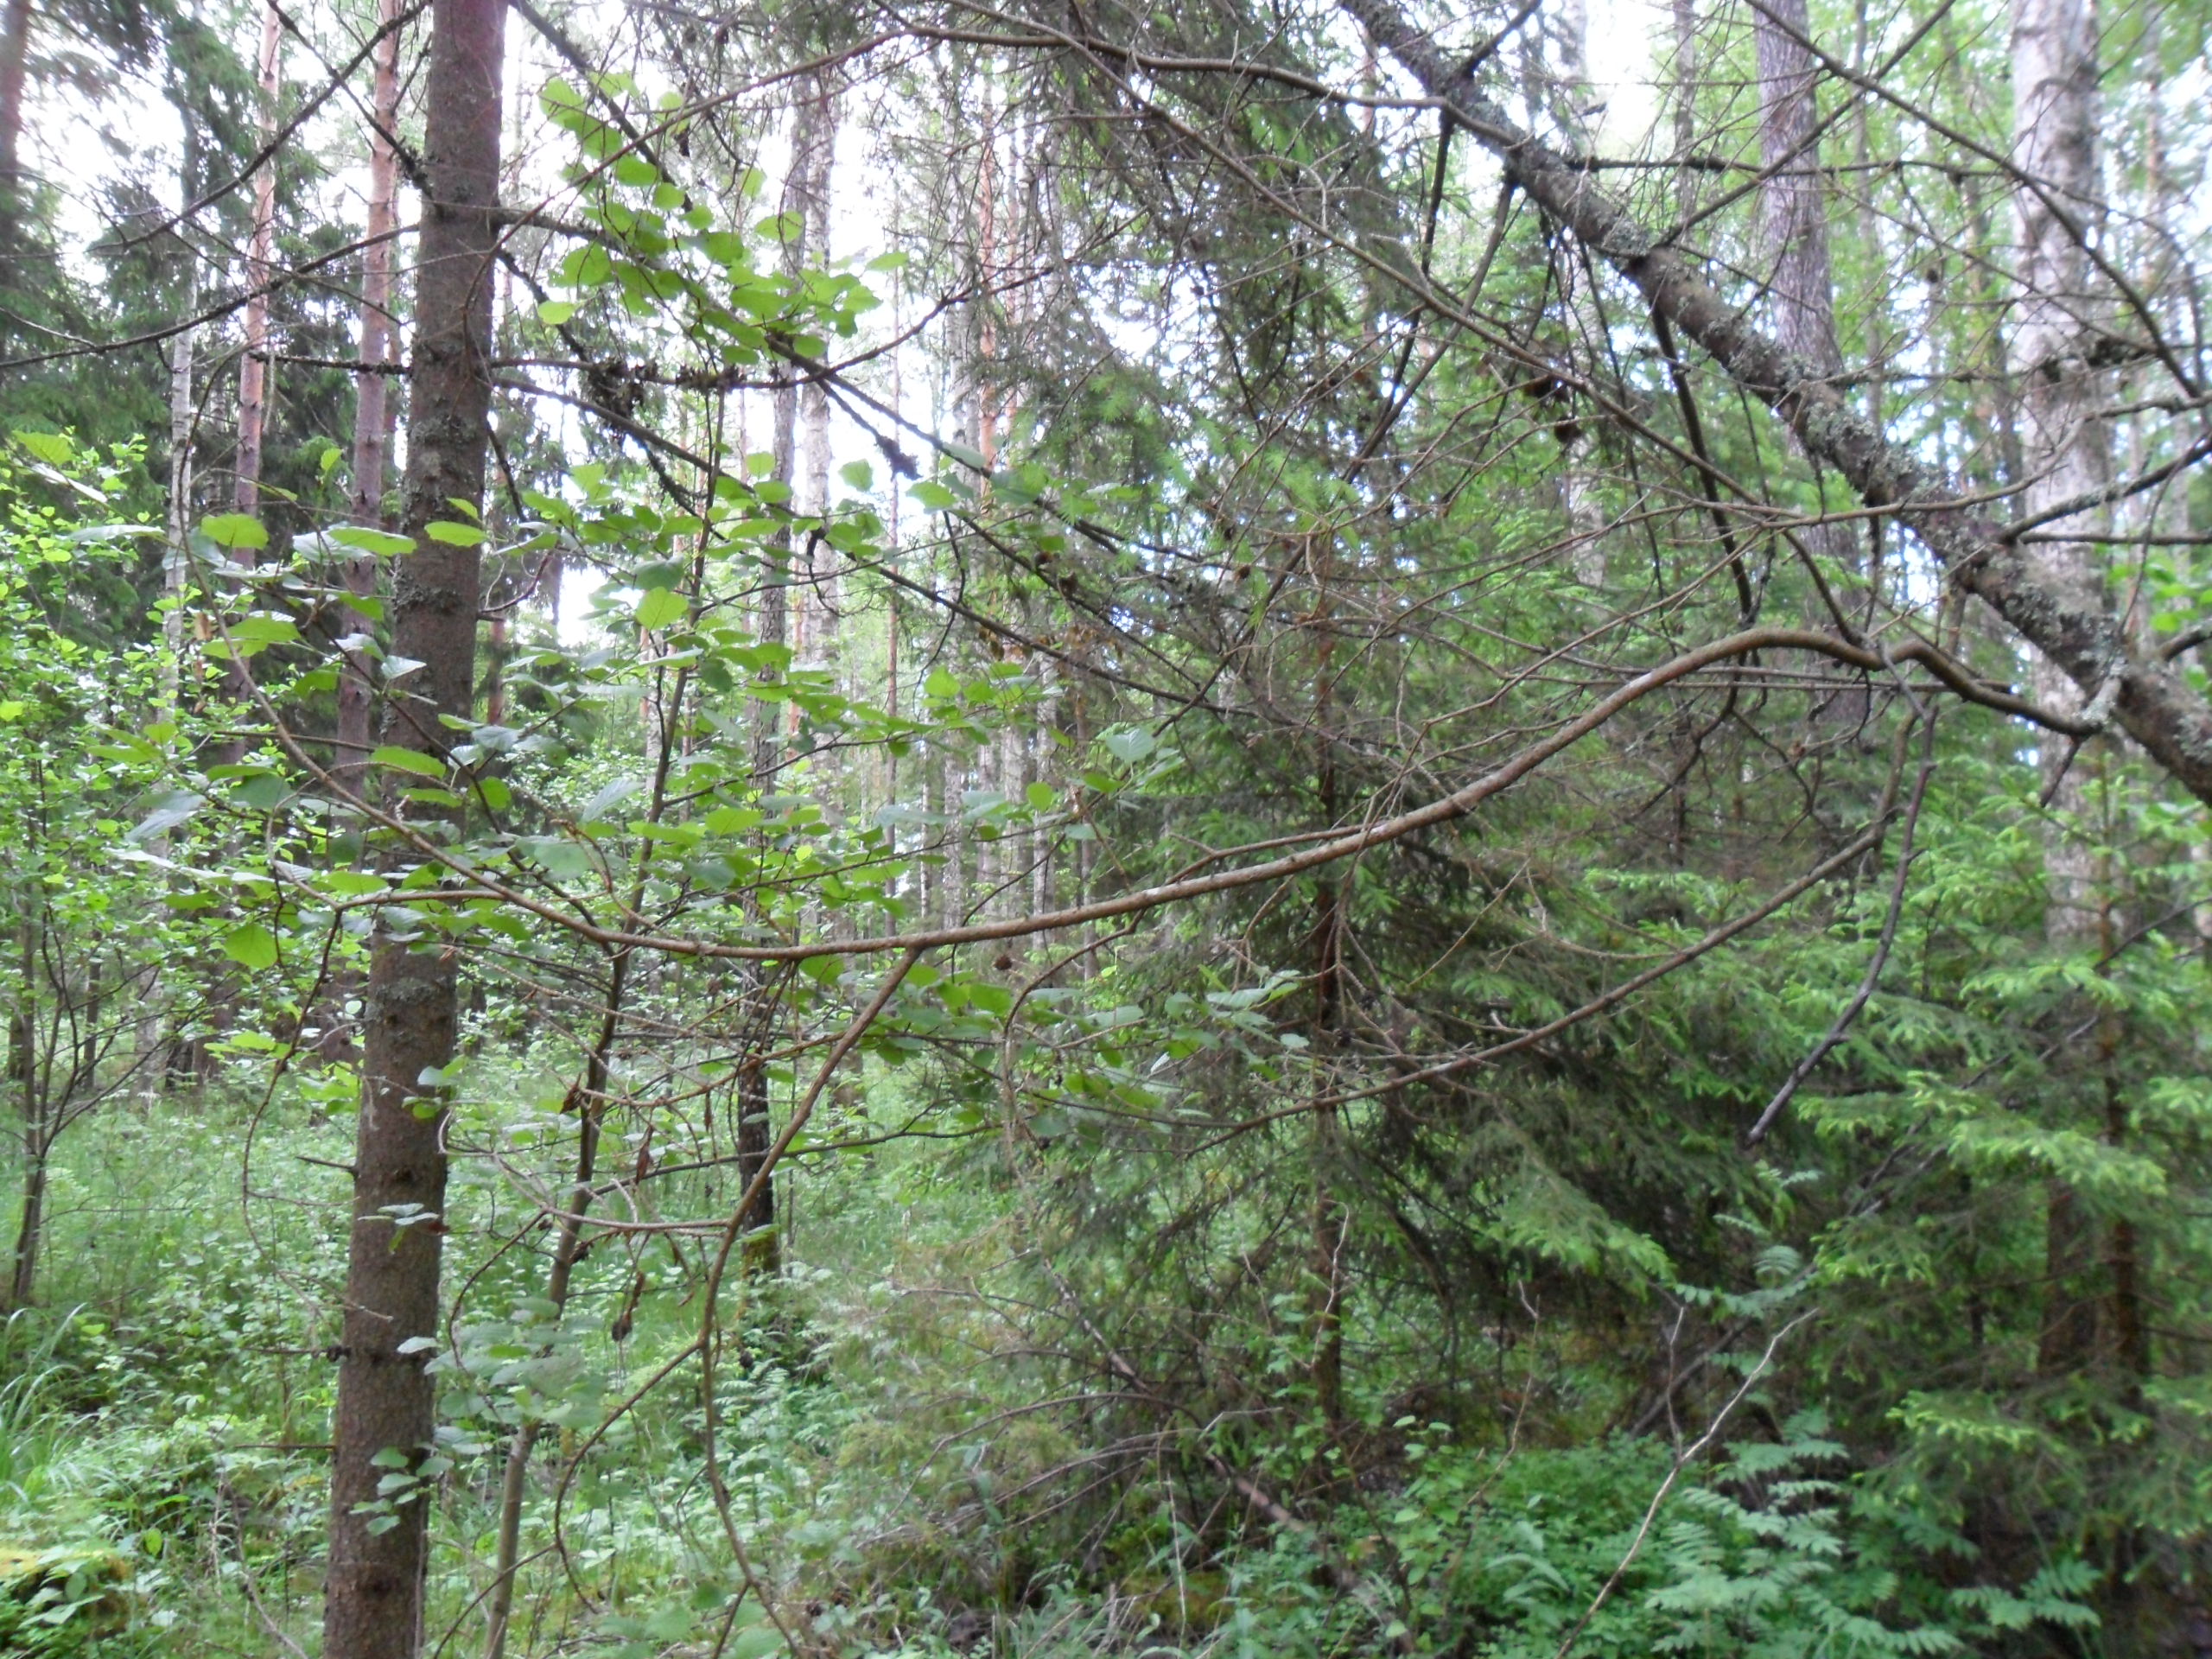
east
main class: Woodland
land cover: Other mixed woodland
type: hemiboreal forest and nemoral coniferous forest and mixed broadleaved-coniferous forest
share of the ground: 50 - 75 %
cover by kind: coniferous forest trees 40 %, broadleaved forest trees 30 %, herbaceous plants 20 %, shrubs 10 %
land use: Forestry
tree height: > 5 m
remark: Temporary flooded
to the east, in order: Other mixed woodland; Spruce dominated mixed woodland; Ditches and canals; Spontaneously vegetated surfaces; Ditches and canals; Shruby margins; Paved roads, cycling and walking lanes; Shruby margins; Ditches and canals; Spontaneously vegetated surfaces
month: June
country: LV
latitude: 57.4875
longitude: 22.1074
